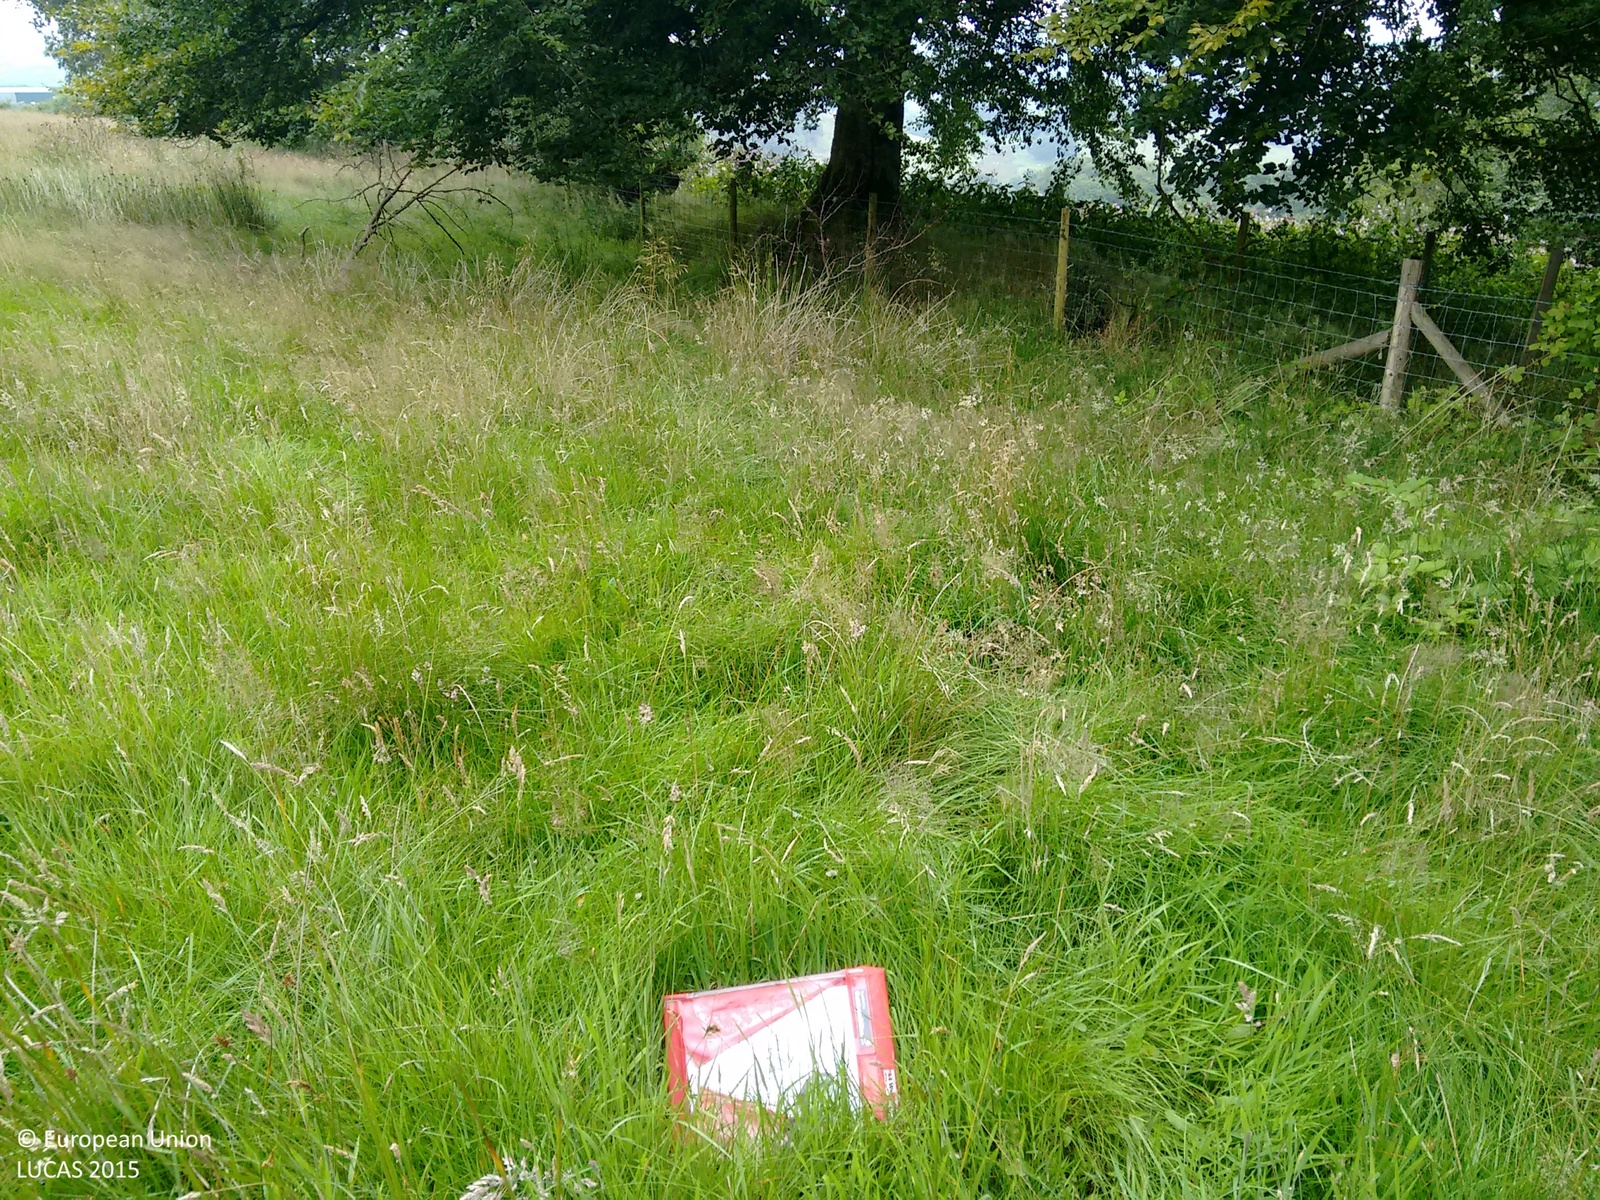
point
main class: Grassland
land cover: Grassland without tree/shrub cover
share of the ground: > 75 %
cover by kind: herbaceous plants 100 %
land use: Agriculture (excluding fallow land and kitchen gardens)
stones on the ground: < 10 %
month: August
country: GB
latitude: 52.0085
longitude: -3.9185
